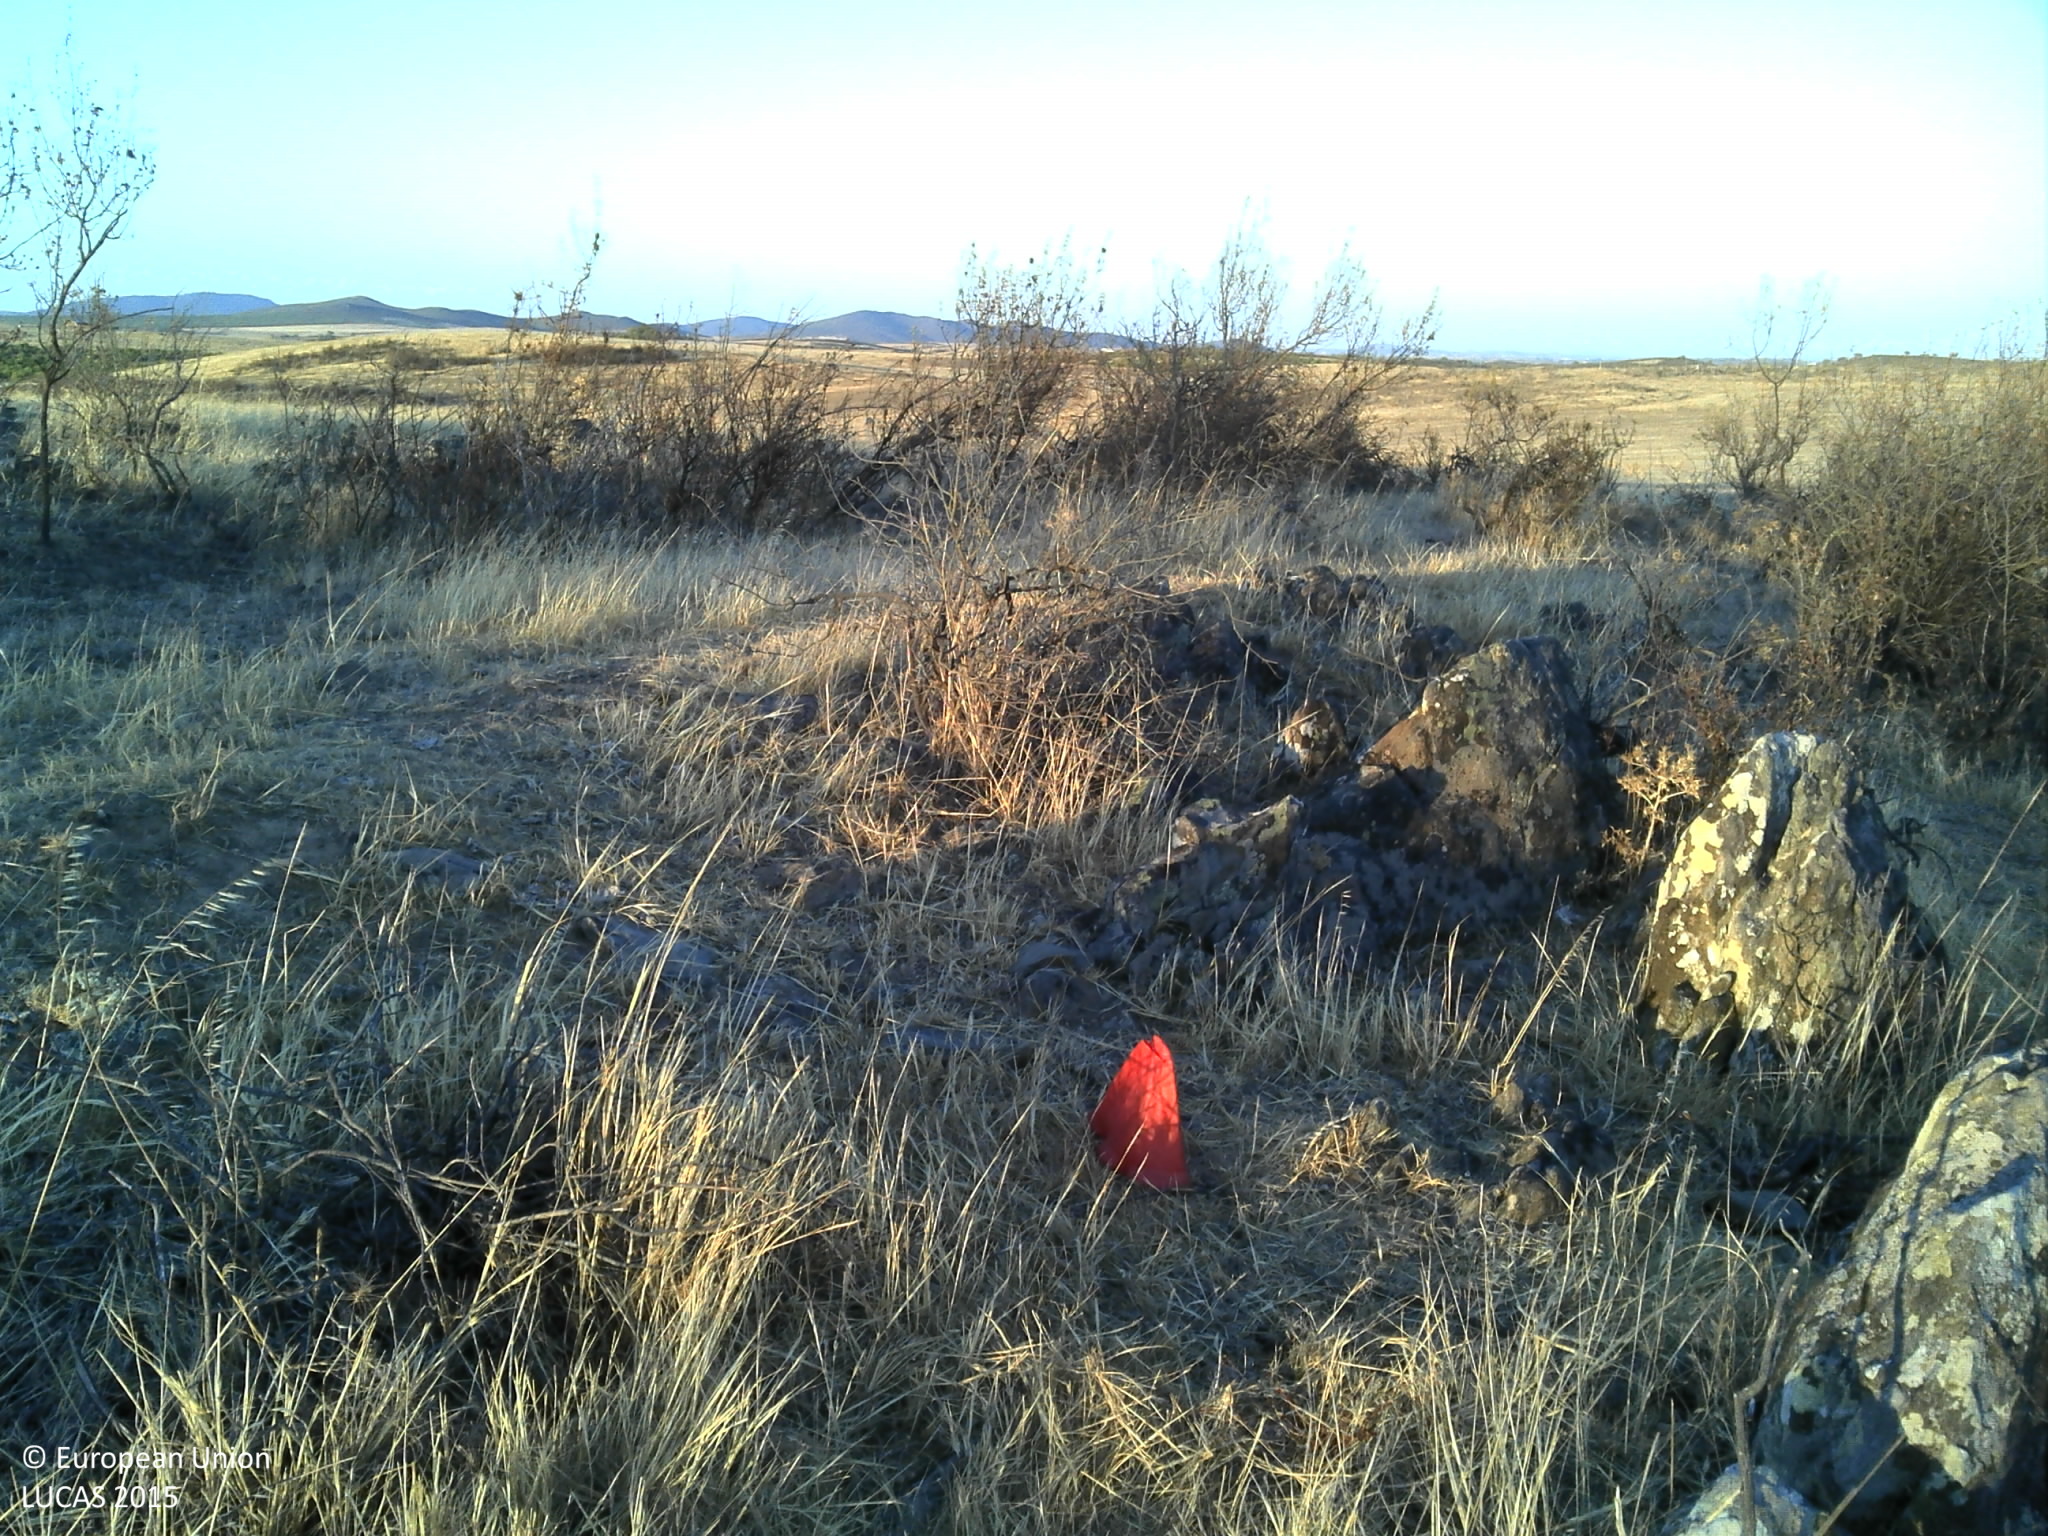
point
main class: Shrubland
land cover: Shrubland without tree cover
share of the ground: 10 - 25 %
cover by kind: unconsolidated bare surface 55 %, shrubs 20 %, herbaceous plants 20 %, consolidated bare surface 5 %
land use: Agriculture (excluding fallow land and kitchen gardens)
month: July
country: PT
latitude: 37.6279
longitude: -7.8893
